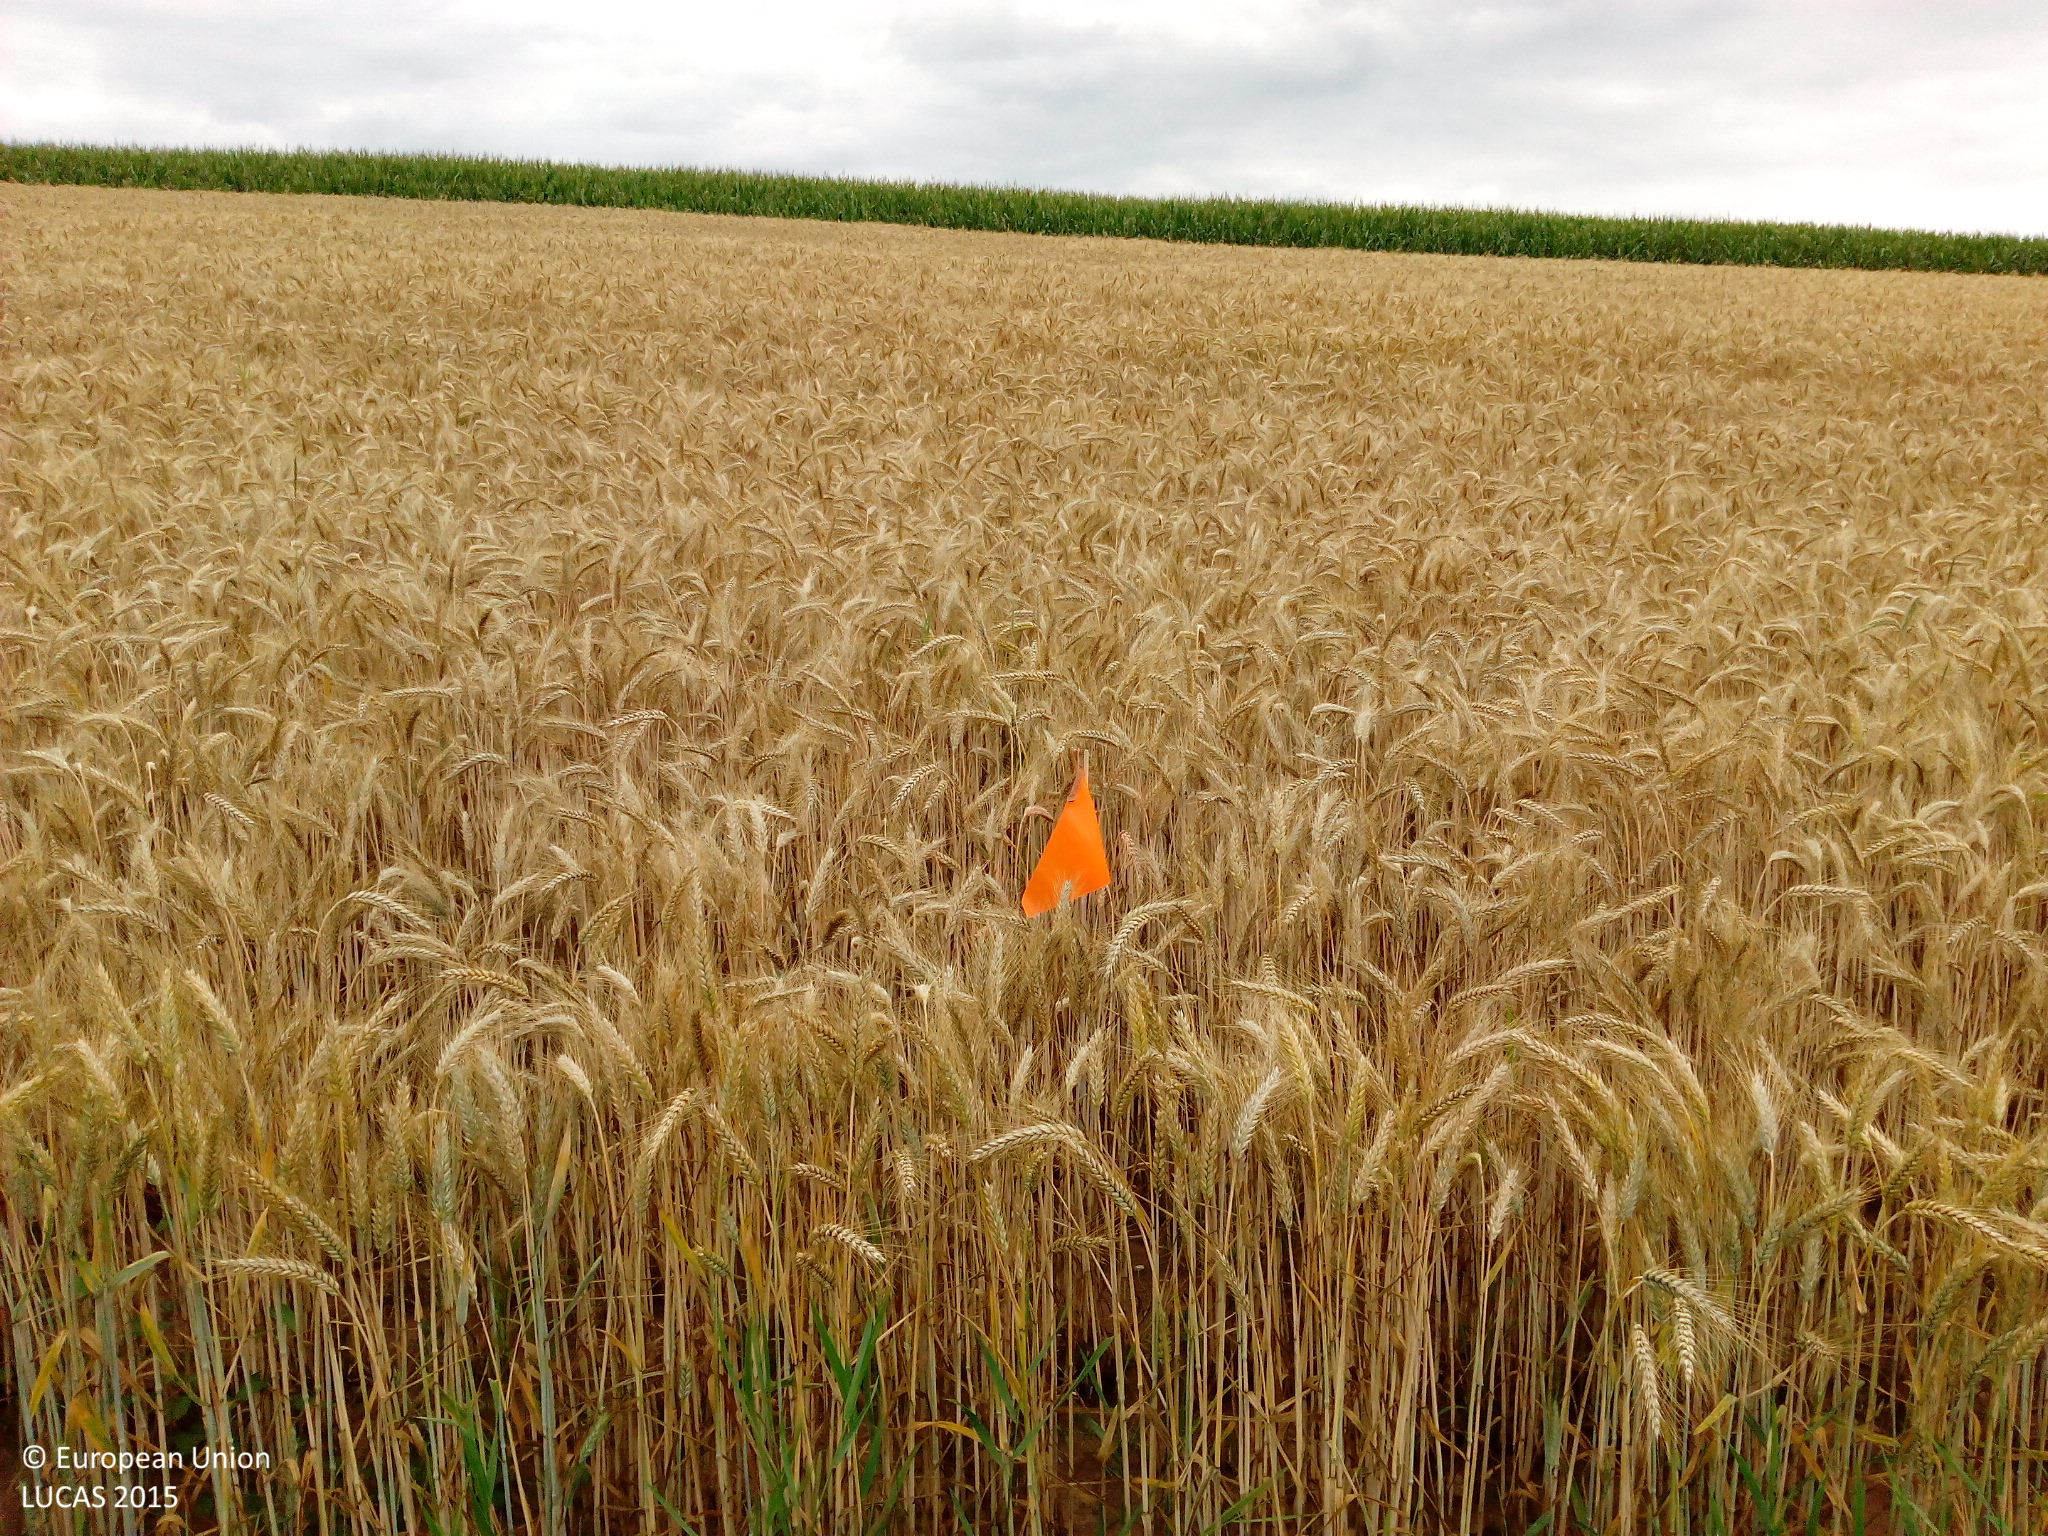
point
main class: Cropland
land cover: Barley
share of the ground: > 75 %
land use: Agriculture (excluding fallow land and kitchen gardens)
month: July
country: DE
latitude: 50.5078
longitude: 9.8731
